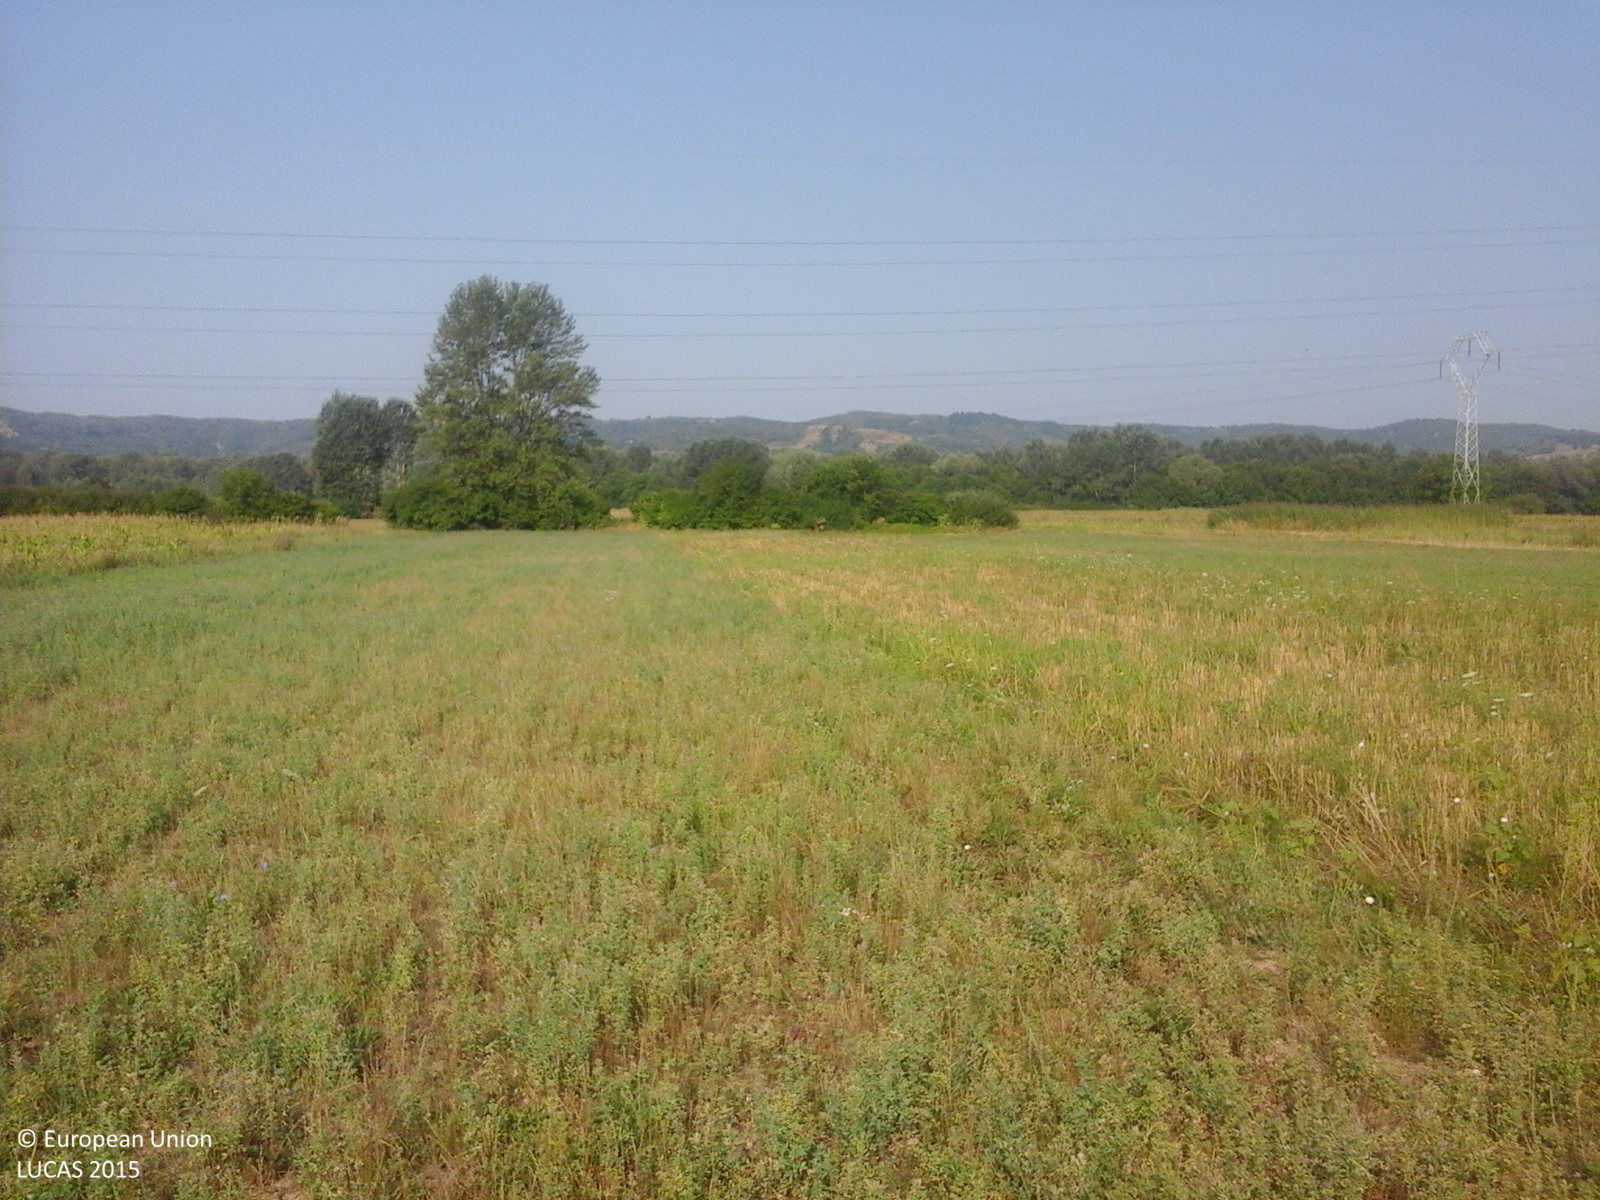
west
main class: Cropland
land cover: Lucerne
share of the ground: > 75 %
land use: Agriculture (excluding fallow land and kitchen gardens)
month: August
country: RO
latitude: 44.8476
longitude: 23.5314
